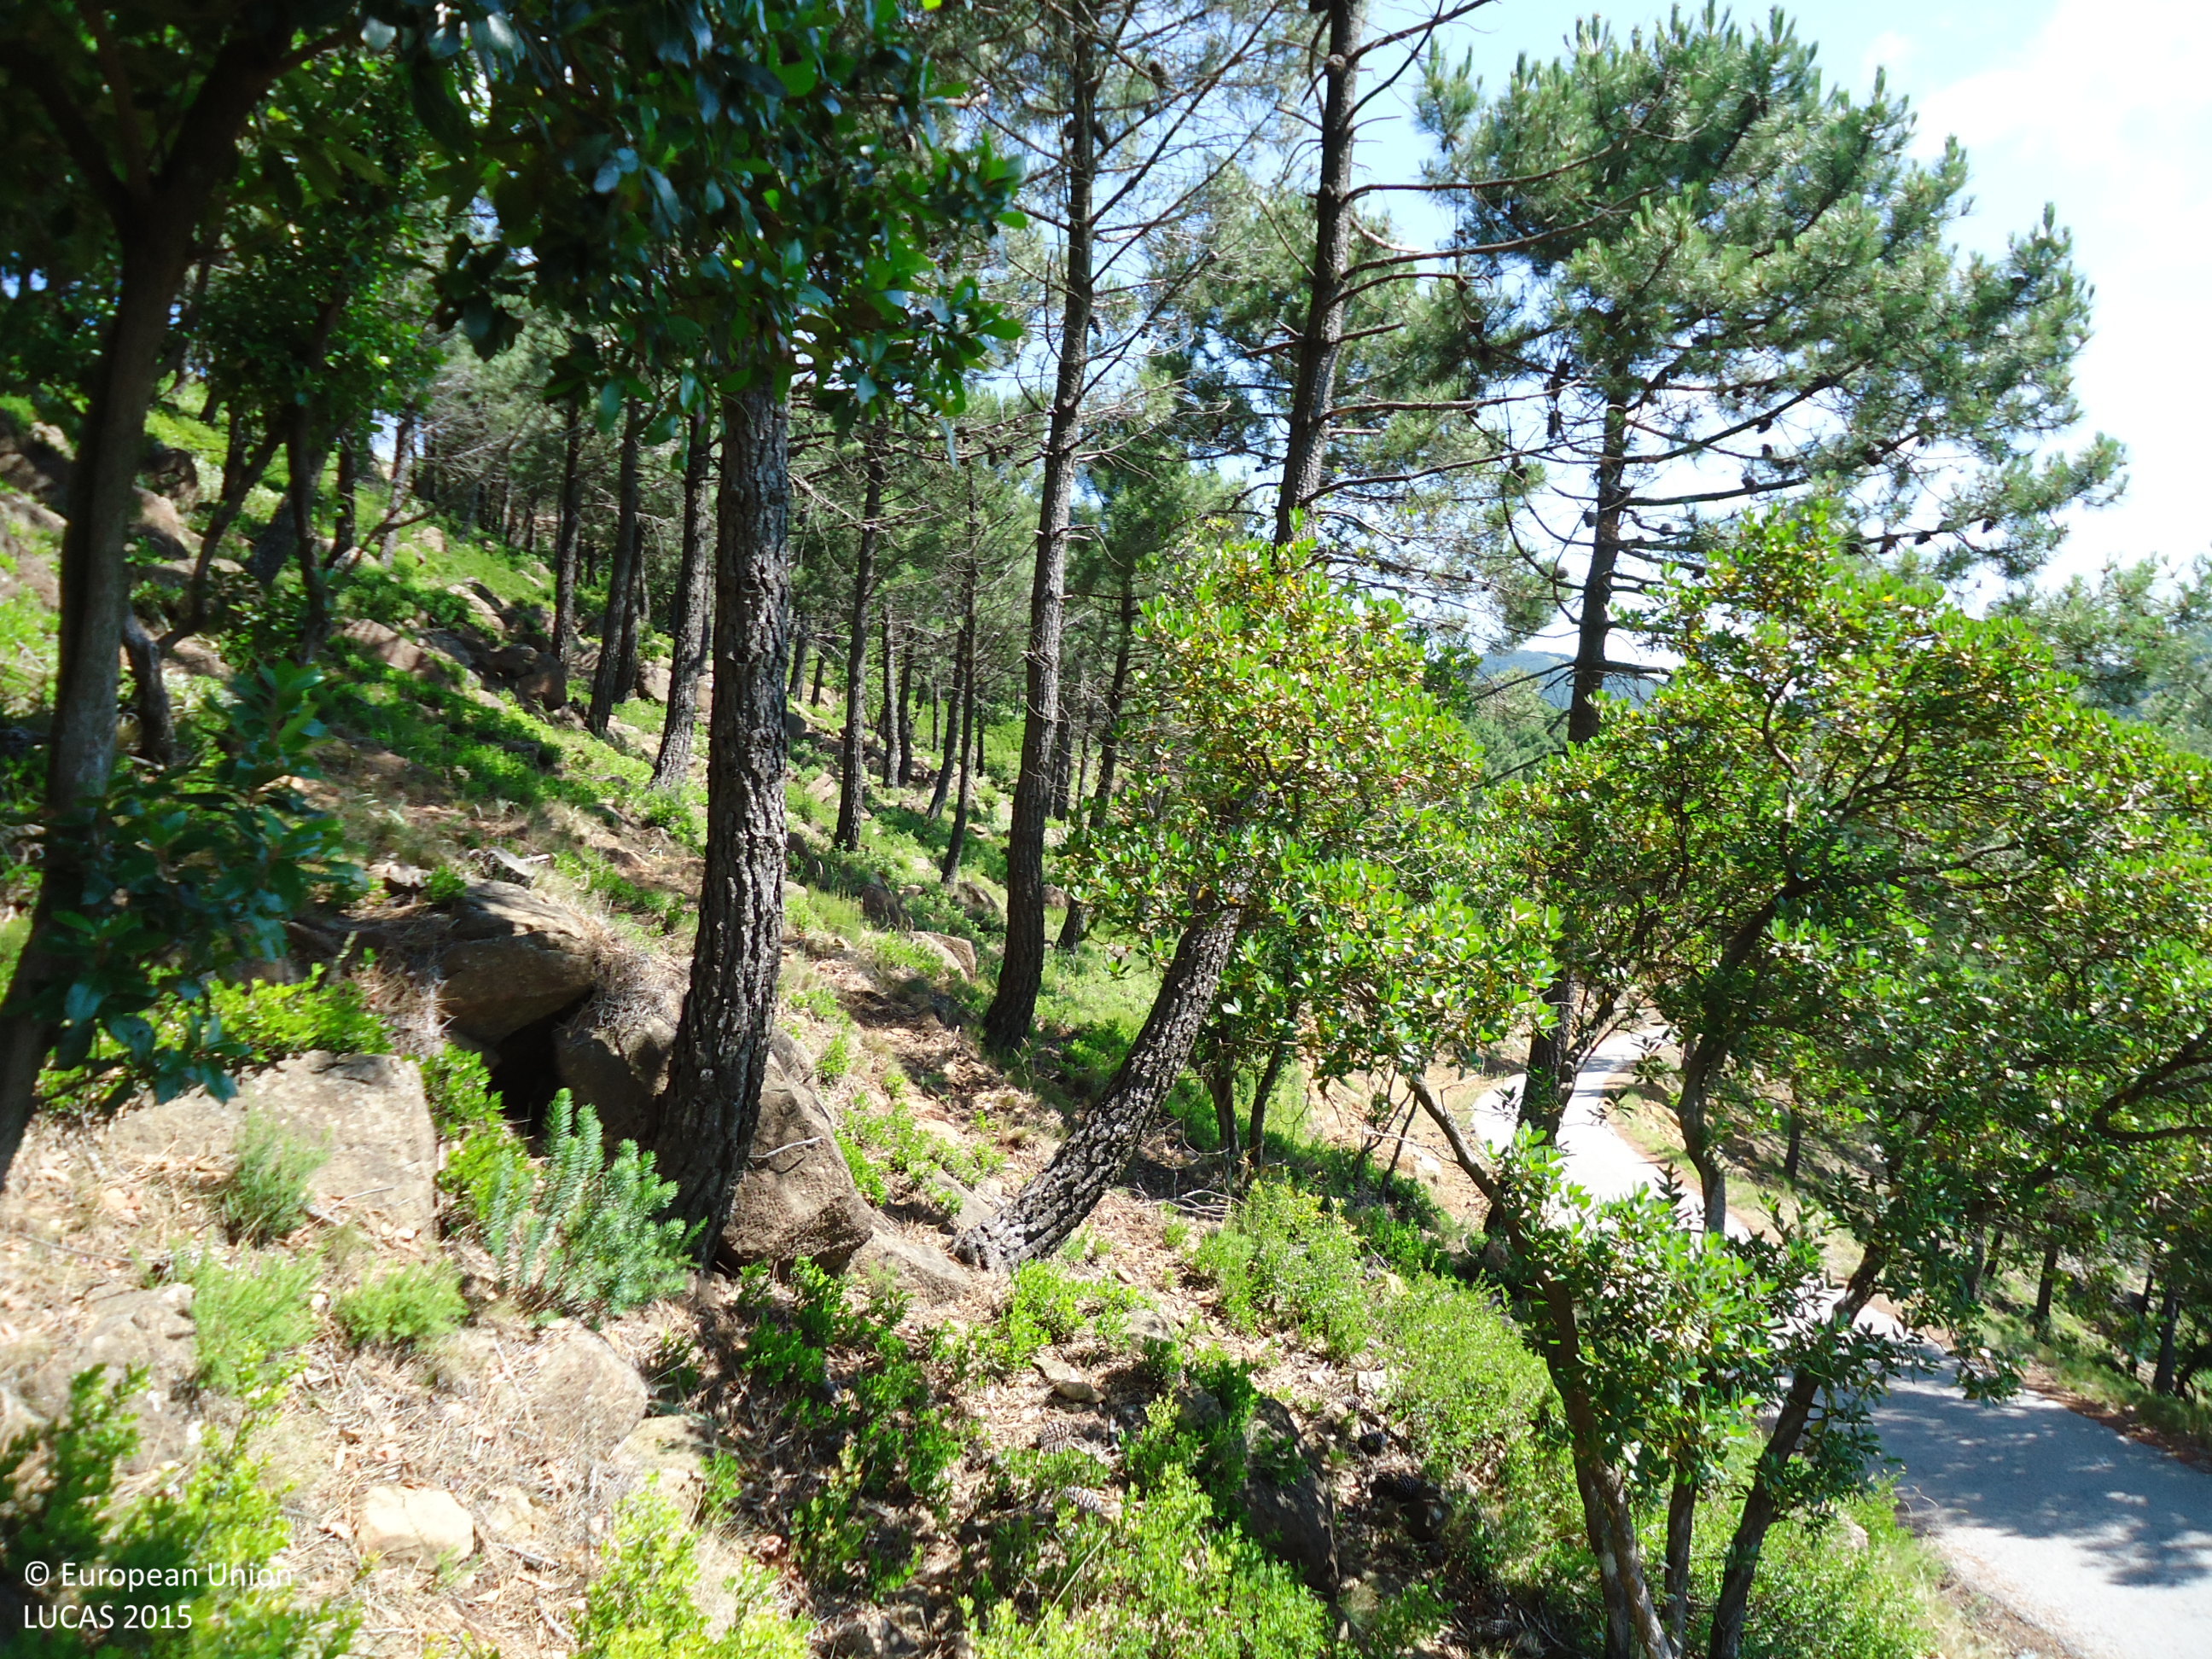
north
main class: Woodland
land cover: Pine dominated coniferous woodland
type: coniferous forest of the mediterranean region
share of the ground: > 75 %
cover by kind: coniferous forest trees 85 %, shrubs 5 %, herbaceous plants 5 %, consolidated bare surface 5 %
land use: Forestry
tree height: > 5 m
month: June
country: ES
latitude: 36.5012
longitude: -5.1899
